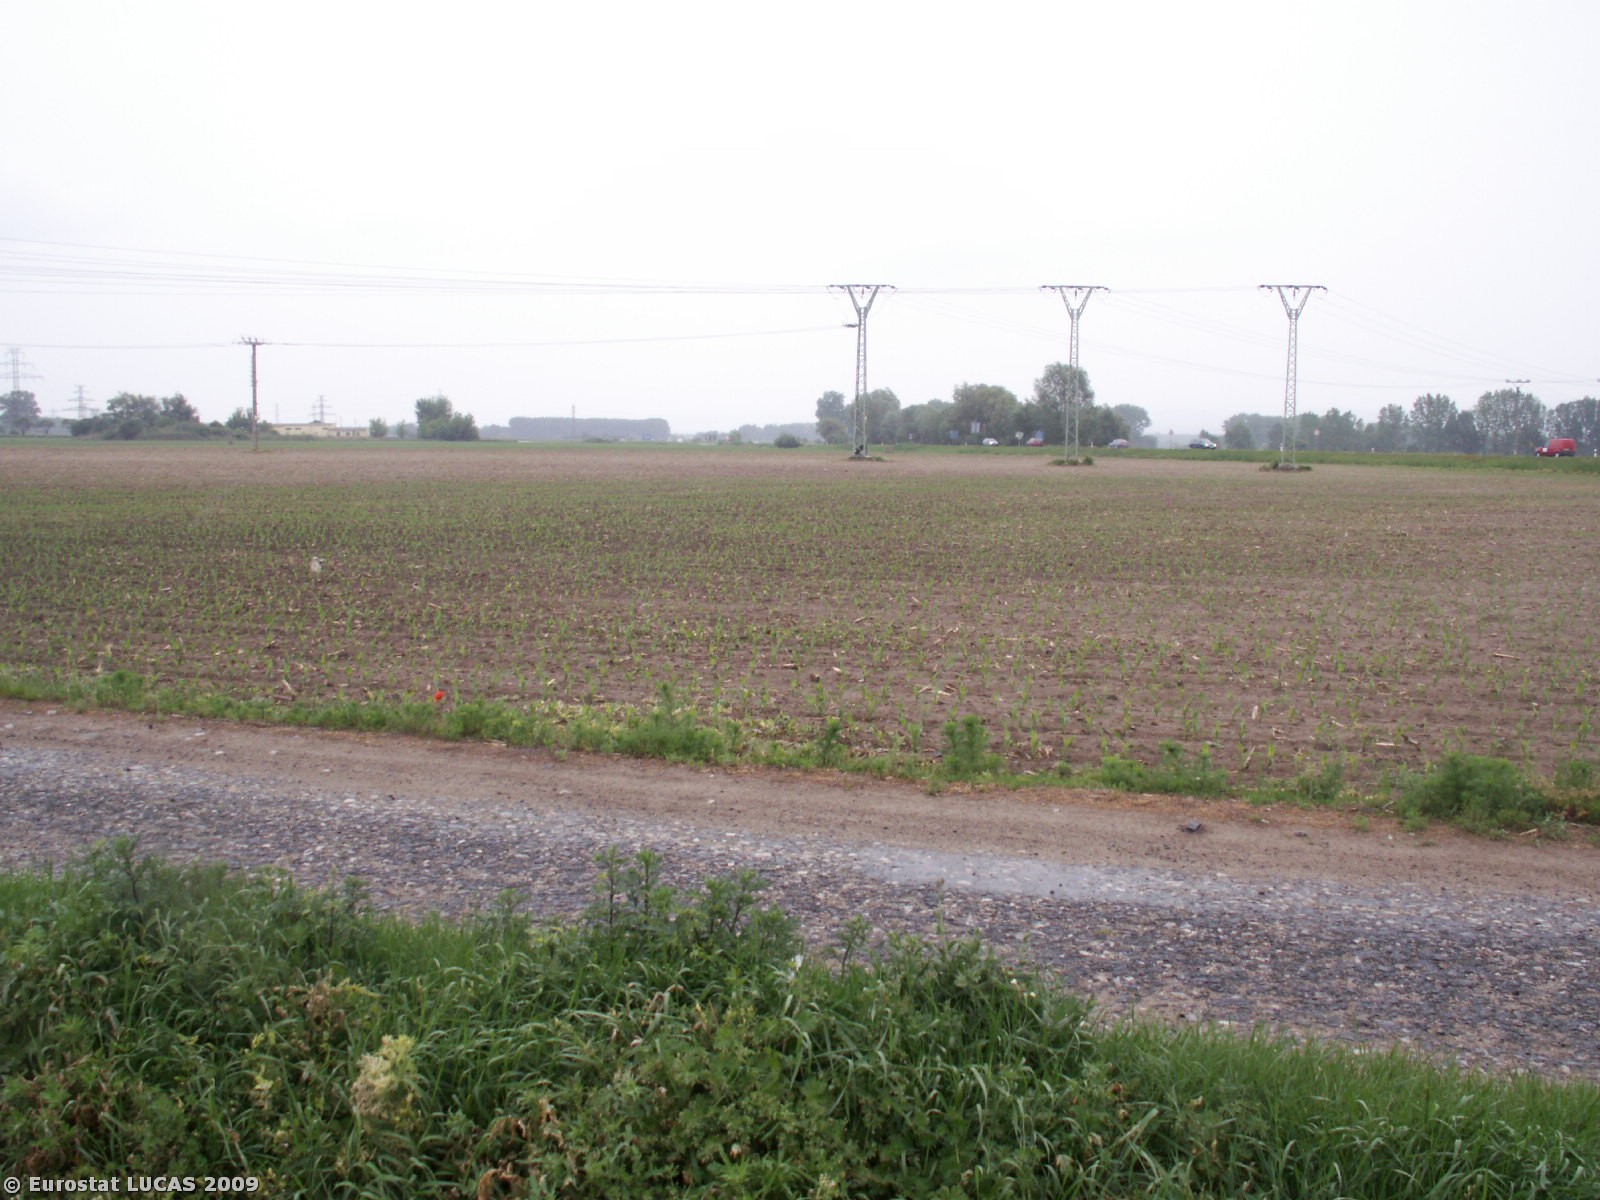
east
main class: Cropland
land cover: Maize
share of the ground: 10 - 25 %
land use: Agriculture (excluding fallow land and kitchen gardens)
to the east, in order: Maize; Grass margins; Tracks; Grass margins; Maize; Electric lines; Maize; Electric lines; Maize
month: May
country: CZ
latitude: 48.8769
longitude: 17.1406
